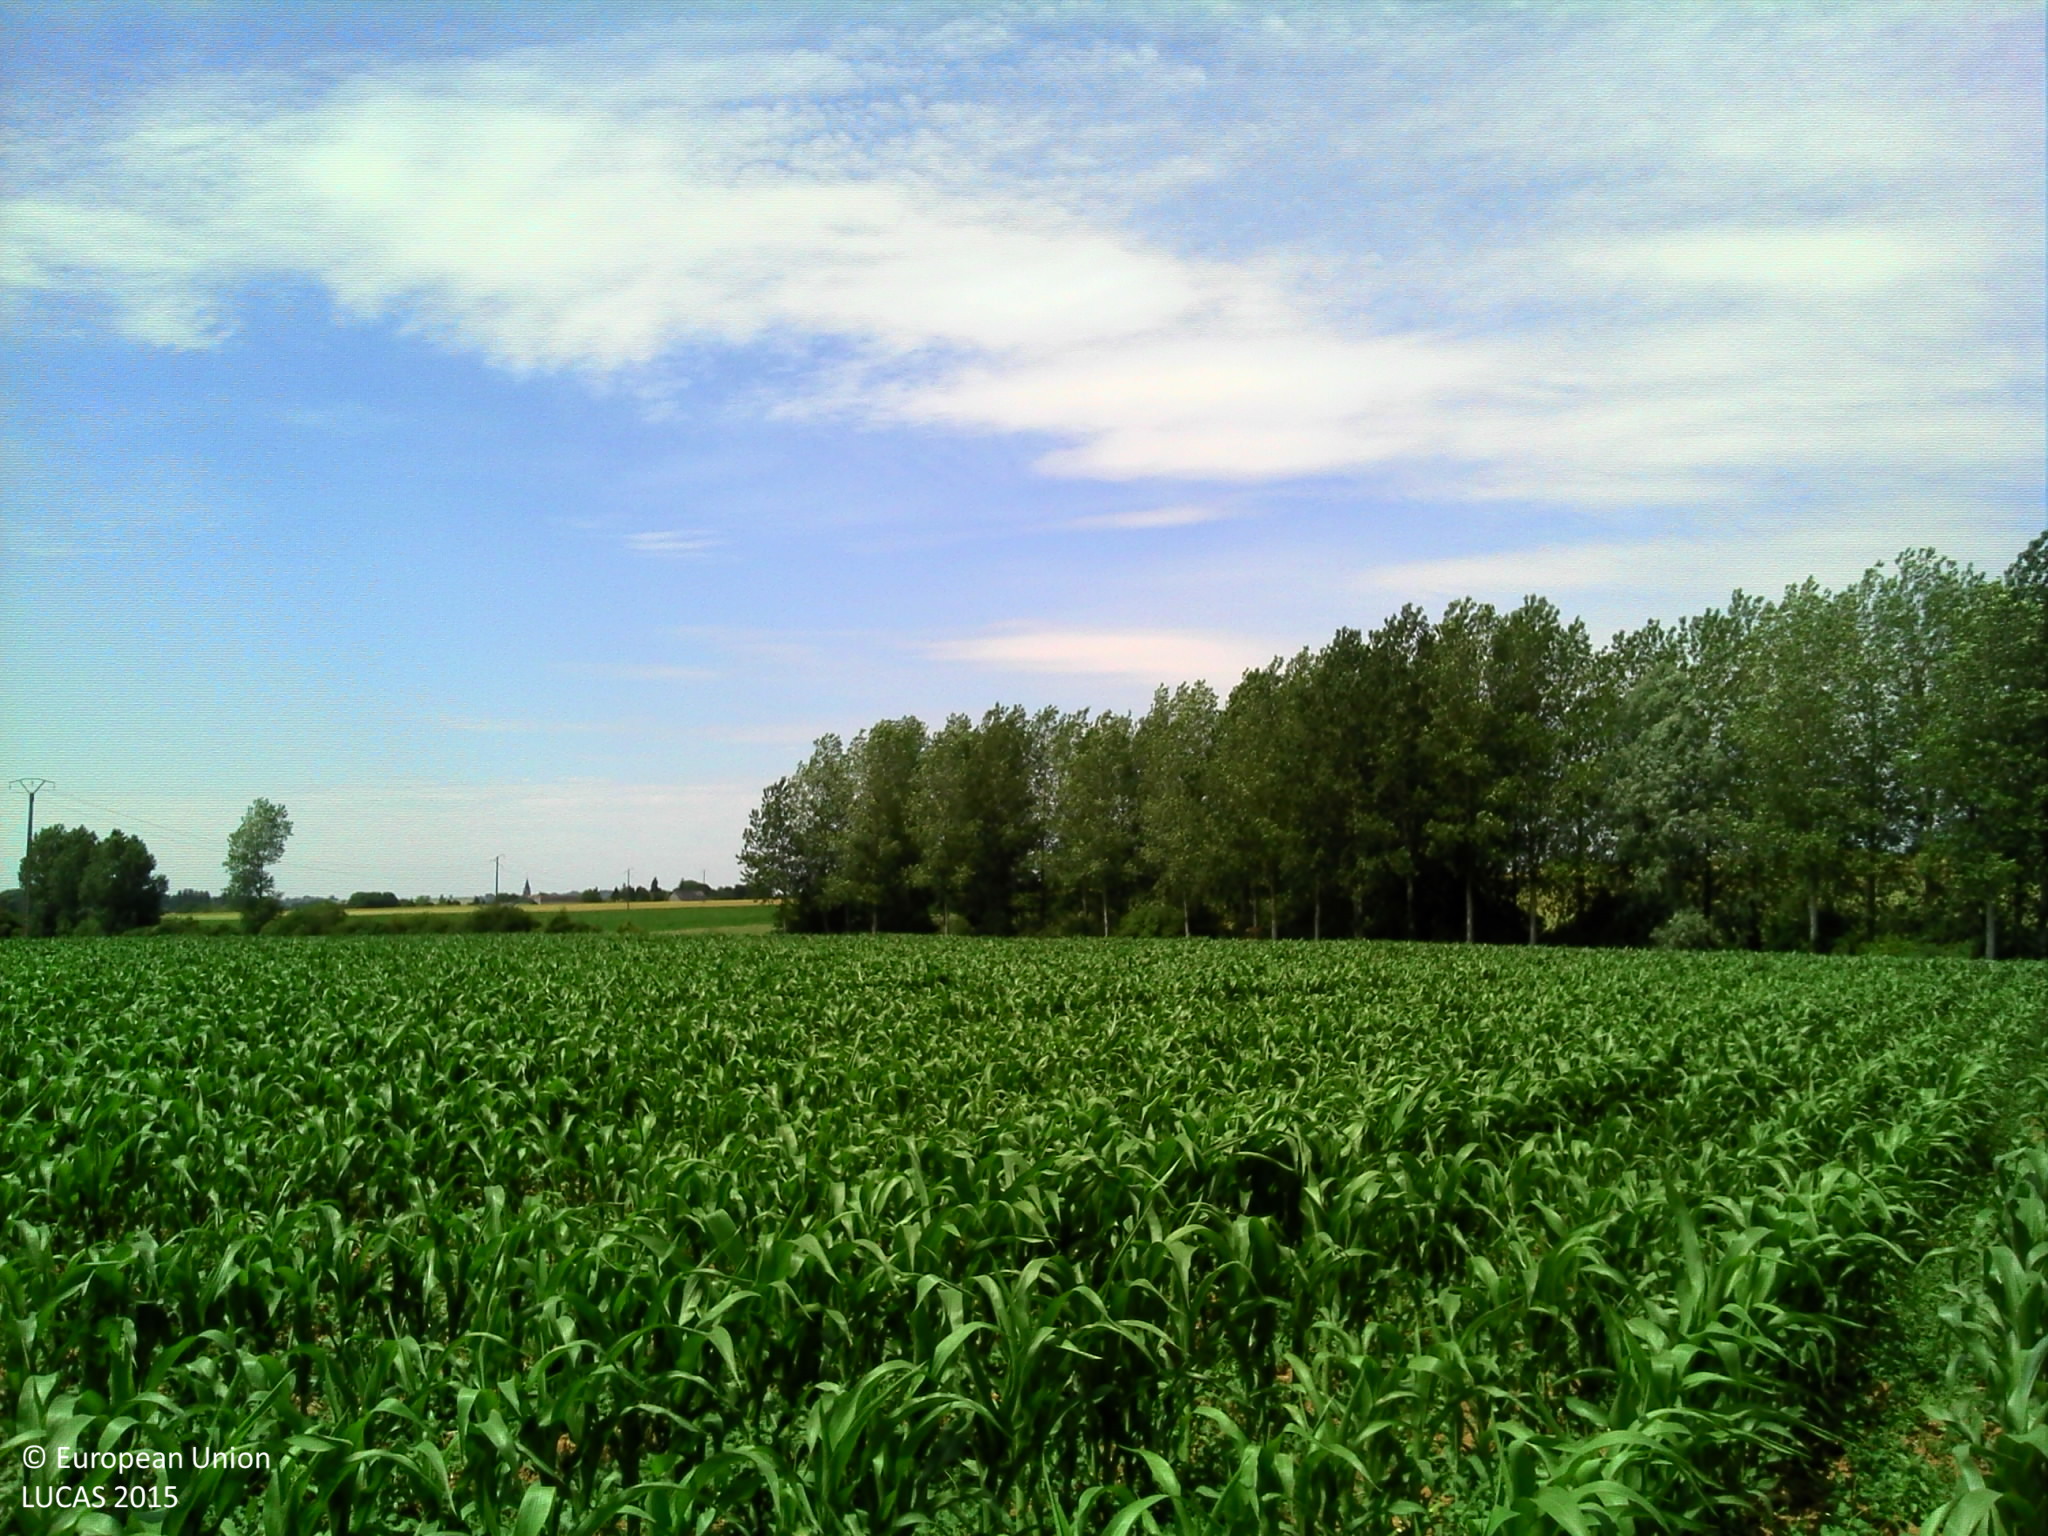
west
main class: Cropland
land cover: Maize
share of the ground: > 75 %
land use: Agriculture (excluding fallow land and kitchen gardens)
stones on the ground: 10 - 25 %
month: June
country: FR
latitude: 48.3160
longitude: 0.2507
